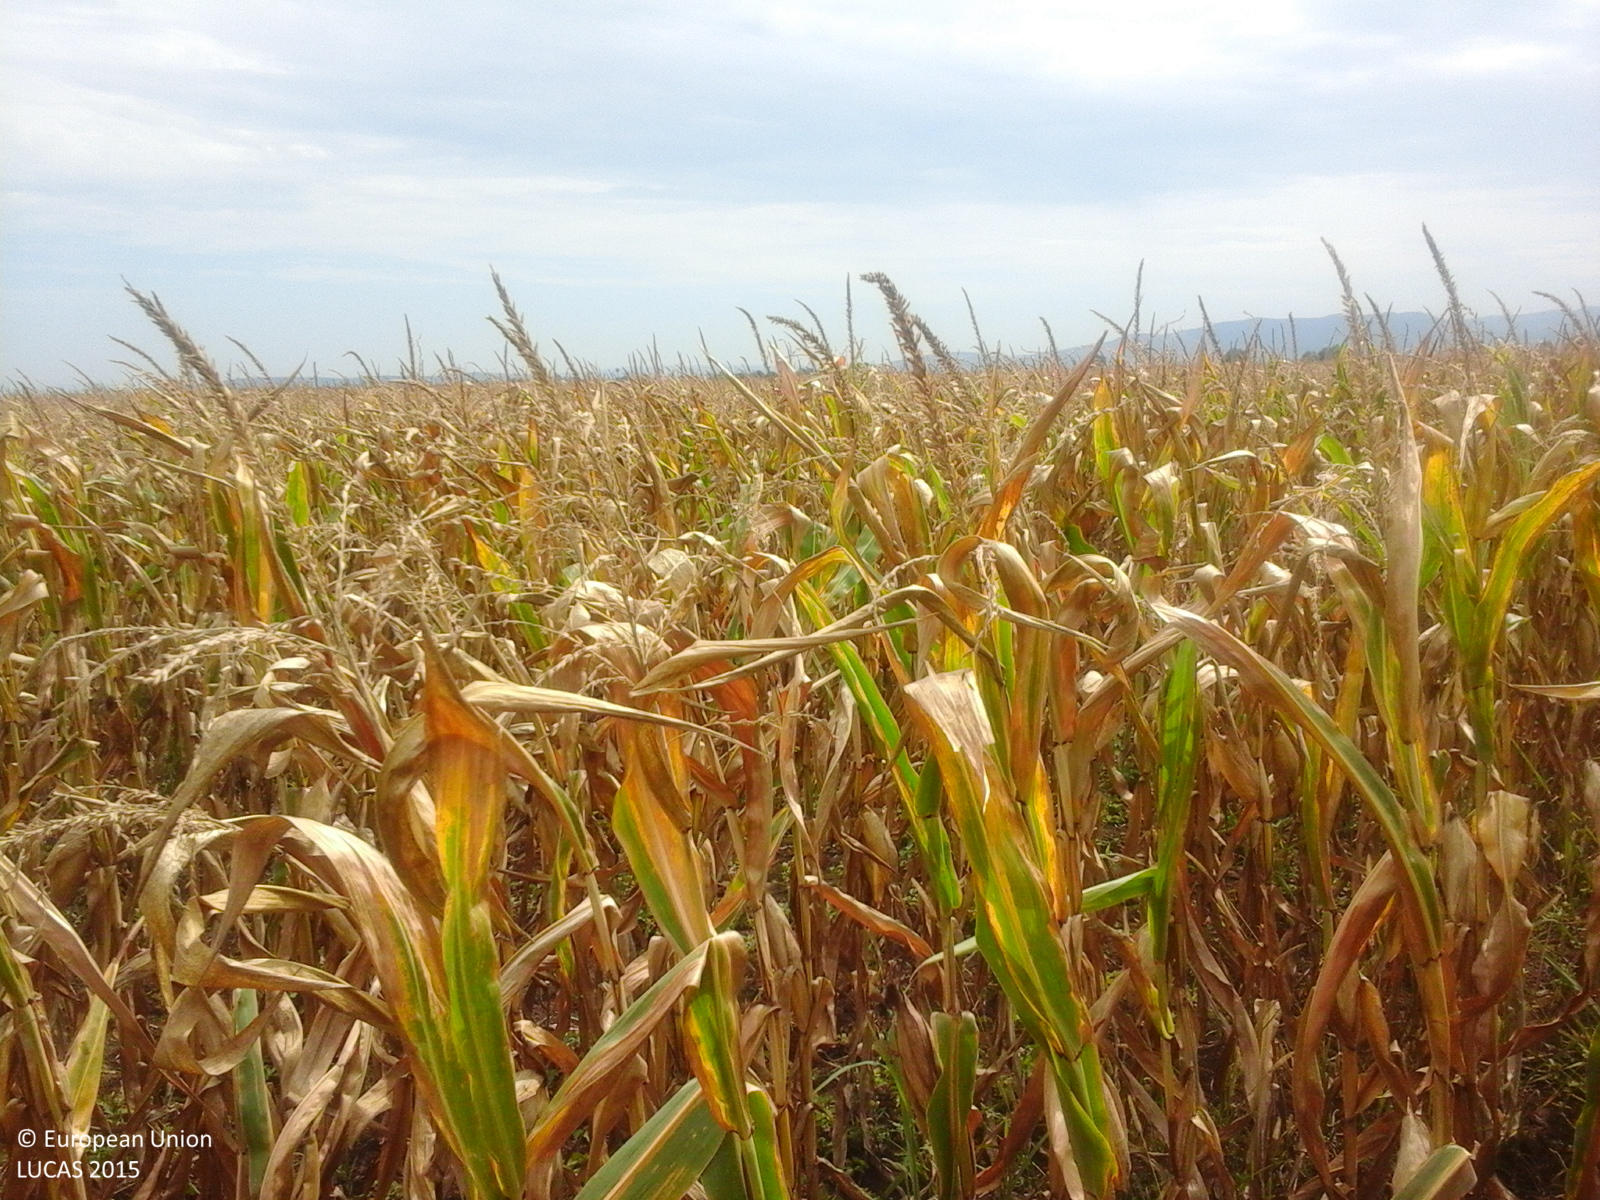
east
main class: Cropland
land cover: Maize
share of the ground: > 75 %
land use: Agriculture (excluding fallow land and kitchen gardens)
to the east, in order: Maize
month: August
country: RO
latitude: 46.3431
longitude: 21.5362
